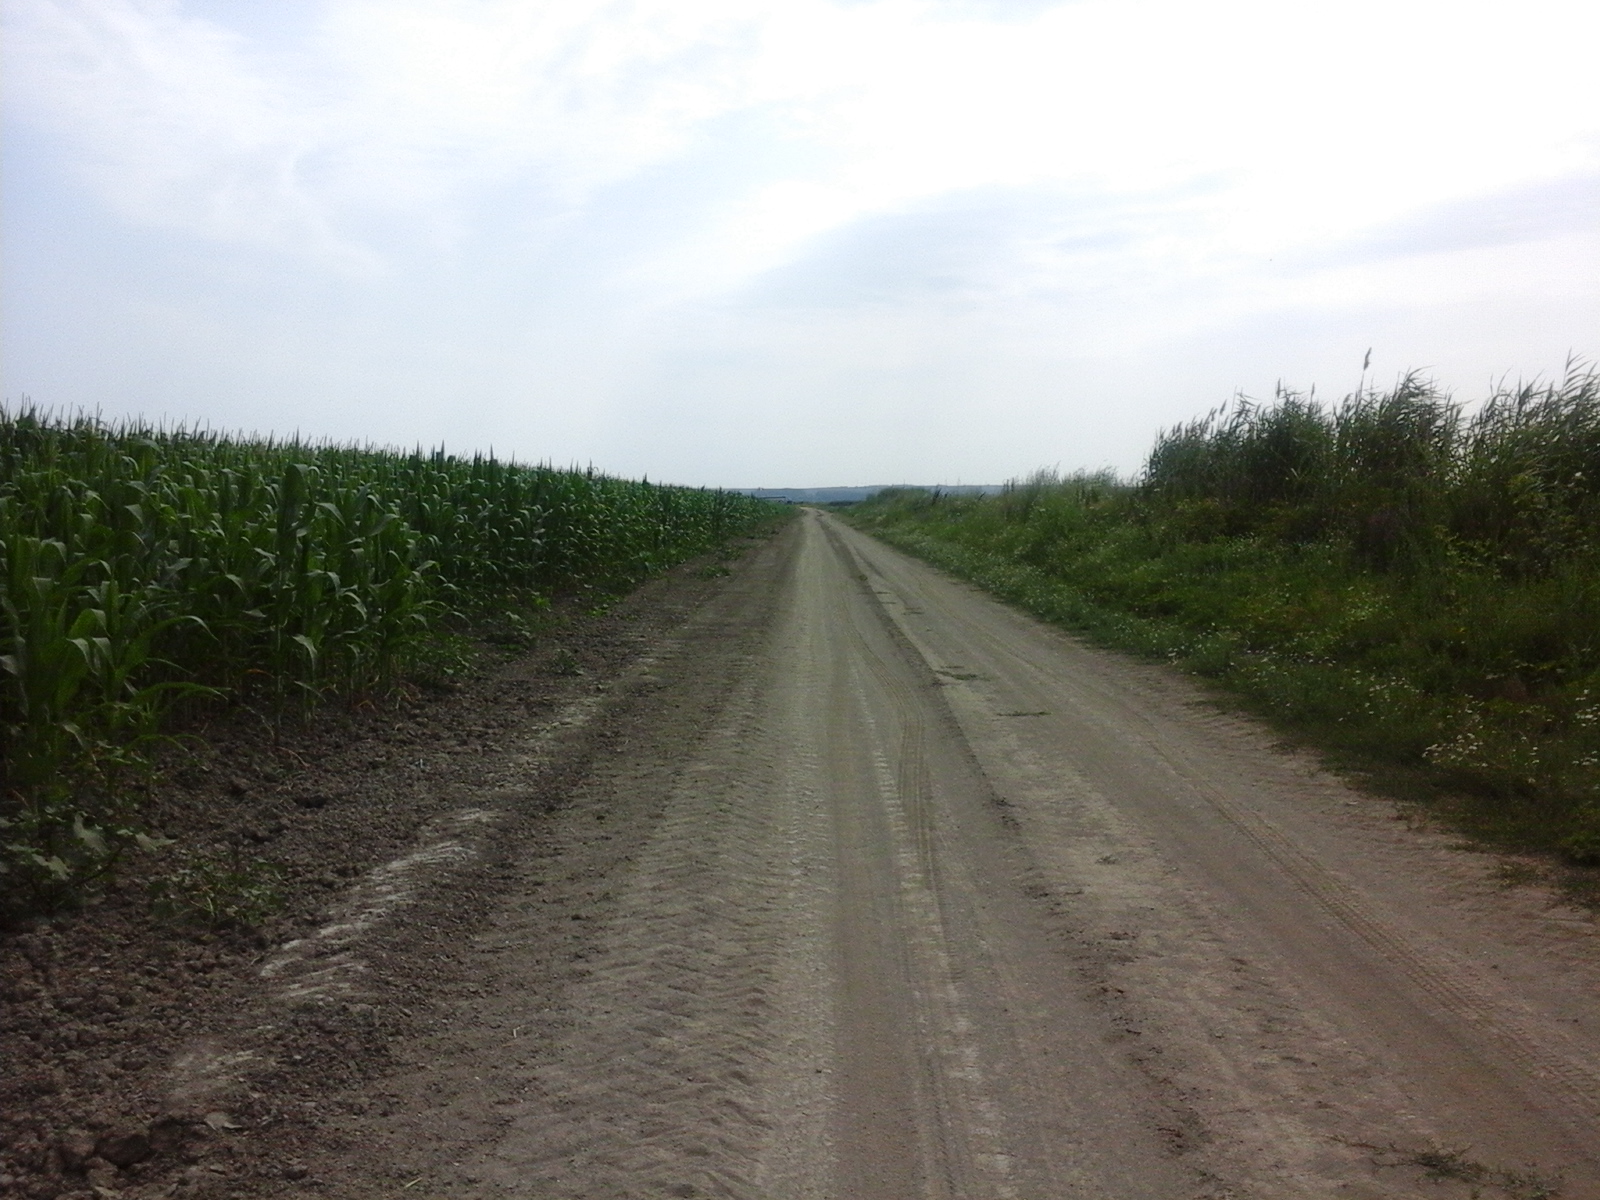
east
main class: Cropland
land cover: Maize
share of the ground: > 75 %
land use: Agriculture (excluding fallow land and kitchen gardens)
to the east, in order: Maize
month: July
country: RO
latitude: 44.4677
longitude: 28.0461
